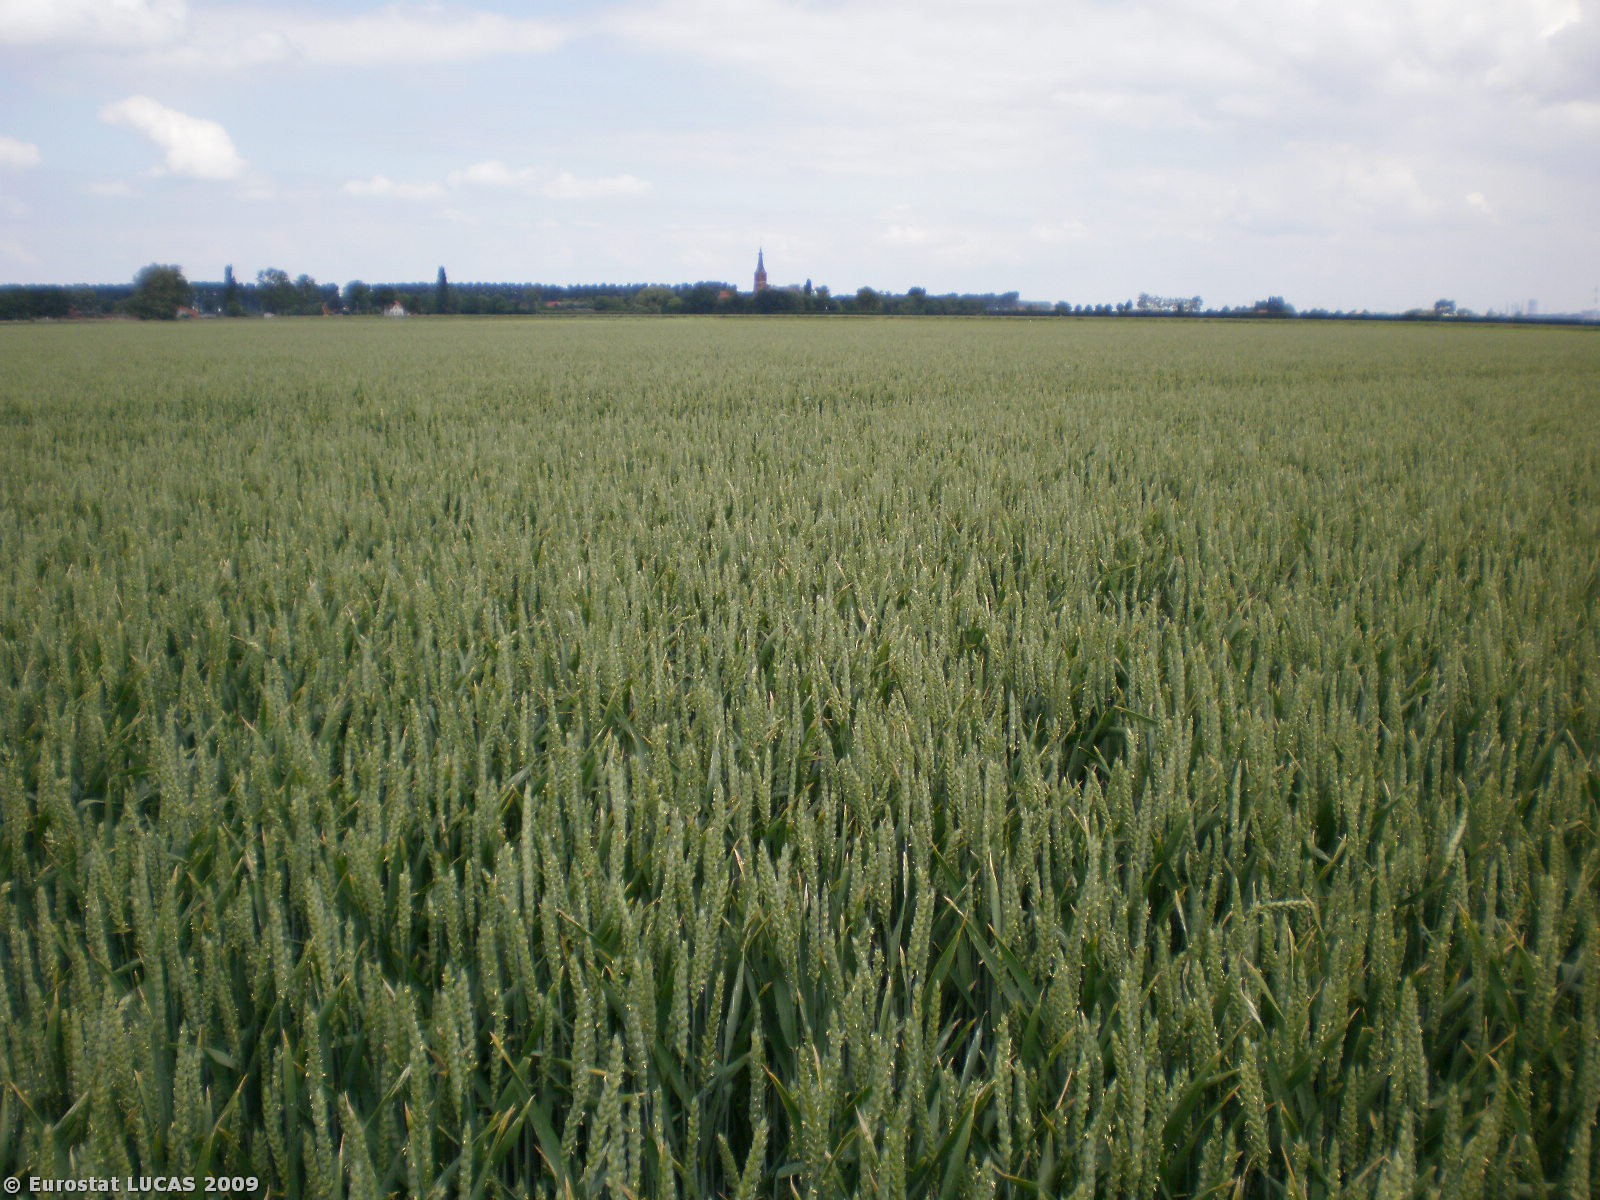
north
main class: Cropland
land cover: Common wheat
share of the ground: > 75 %
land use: Agriculture (excluding fallow land and kitchen gardens)
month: June
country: BE
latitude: 51.3172
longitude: 4.2126
